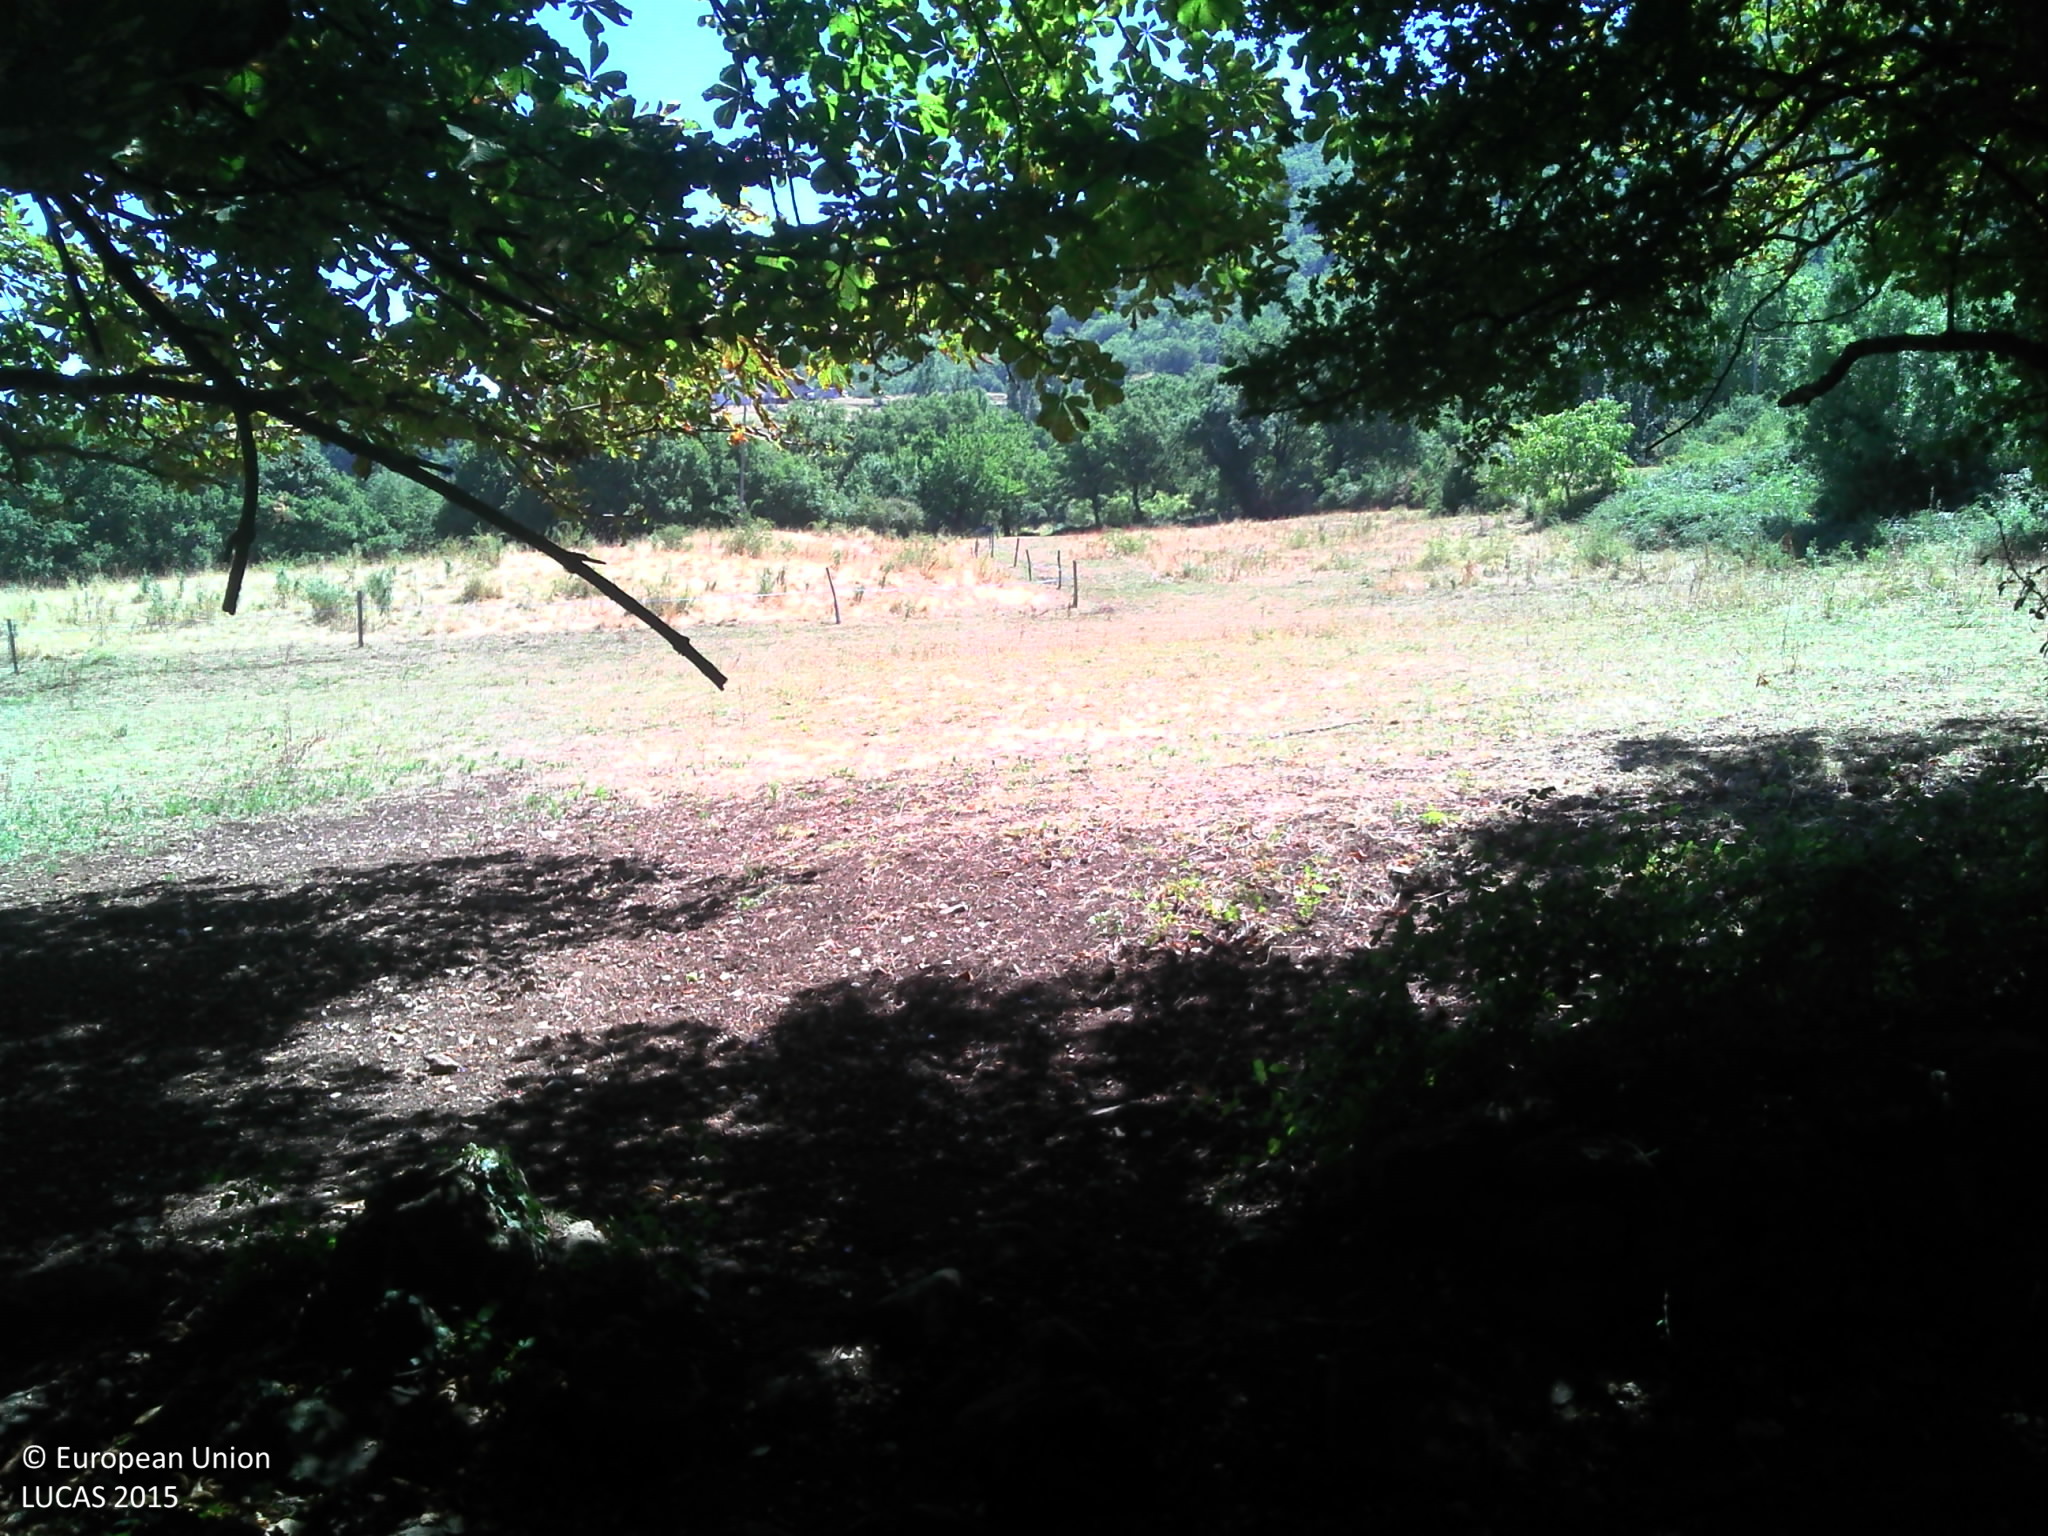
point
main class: Grassland
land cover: Grassland without tree/shrub cover
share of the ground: > 75 %
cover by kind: herbaceous plants 100 %
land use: Agriculture (excluding fallow land and kitchen gardens)
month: July
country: FR
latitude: 44.7154
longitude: 4.5906
